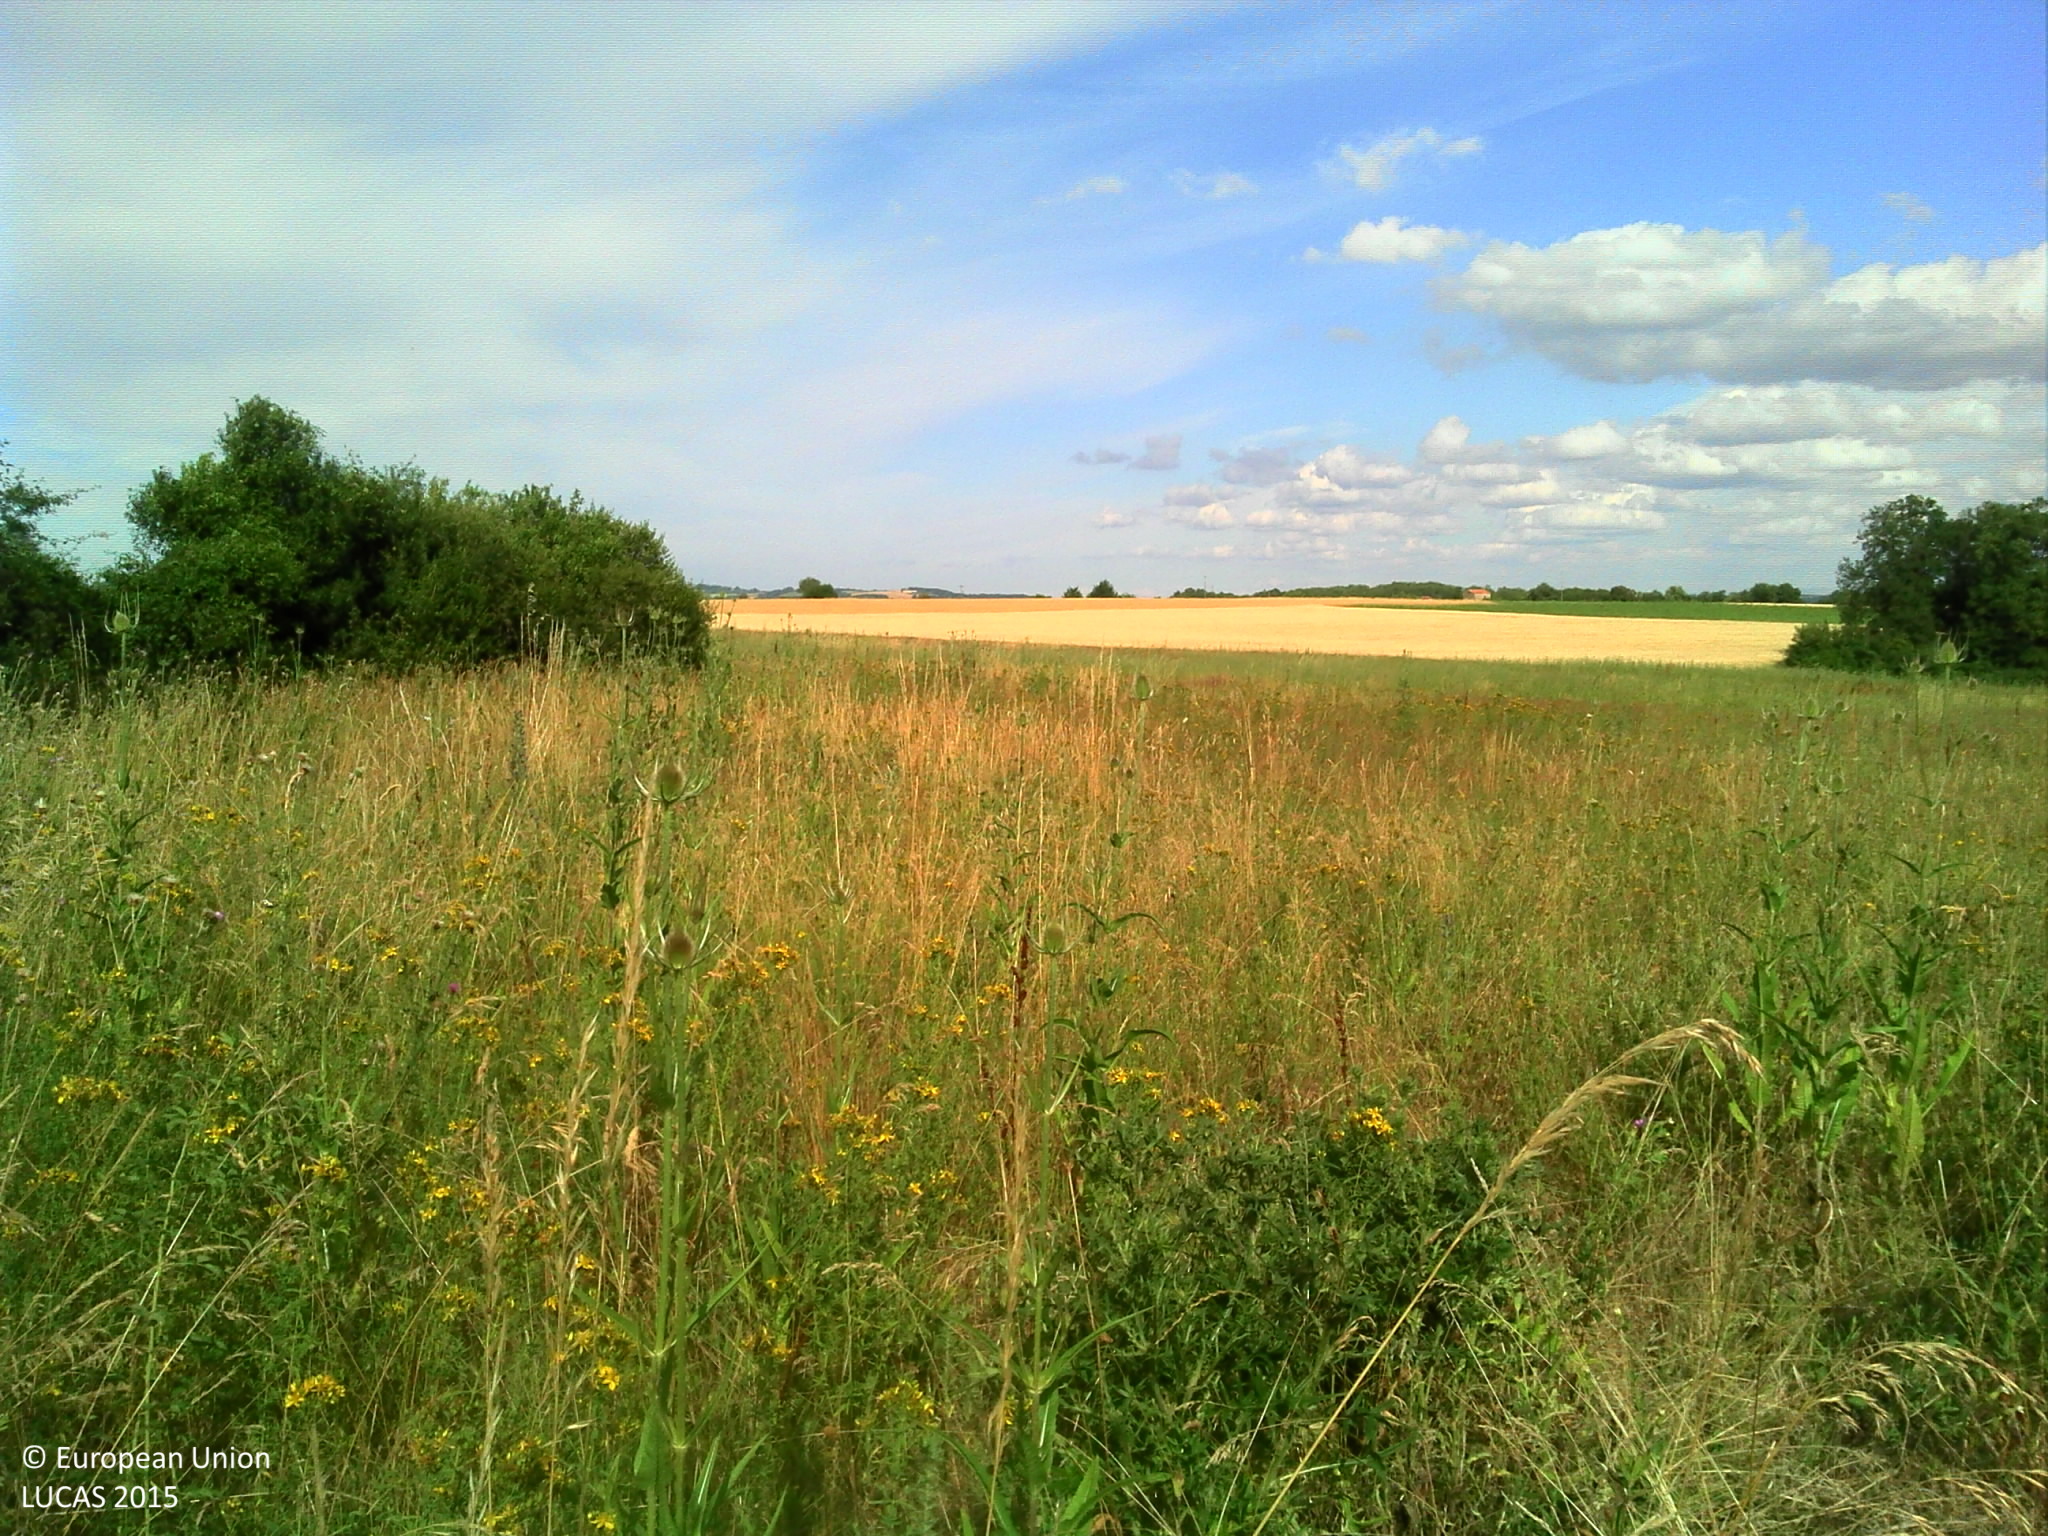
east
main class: Shrubland
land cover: Shrubland with sparse tree cover
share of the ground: > 75 %
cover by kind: shrubs 95 %, broadleaved forest trees 5 %
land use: Abandoned areas
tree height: < 5 m
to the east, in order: Shrubland with sparse tree cover; Grassland without tree/shrub cover; Barley
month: June
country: FR
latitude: 44.0896
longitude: 1.9213
